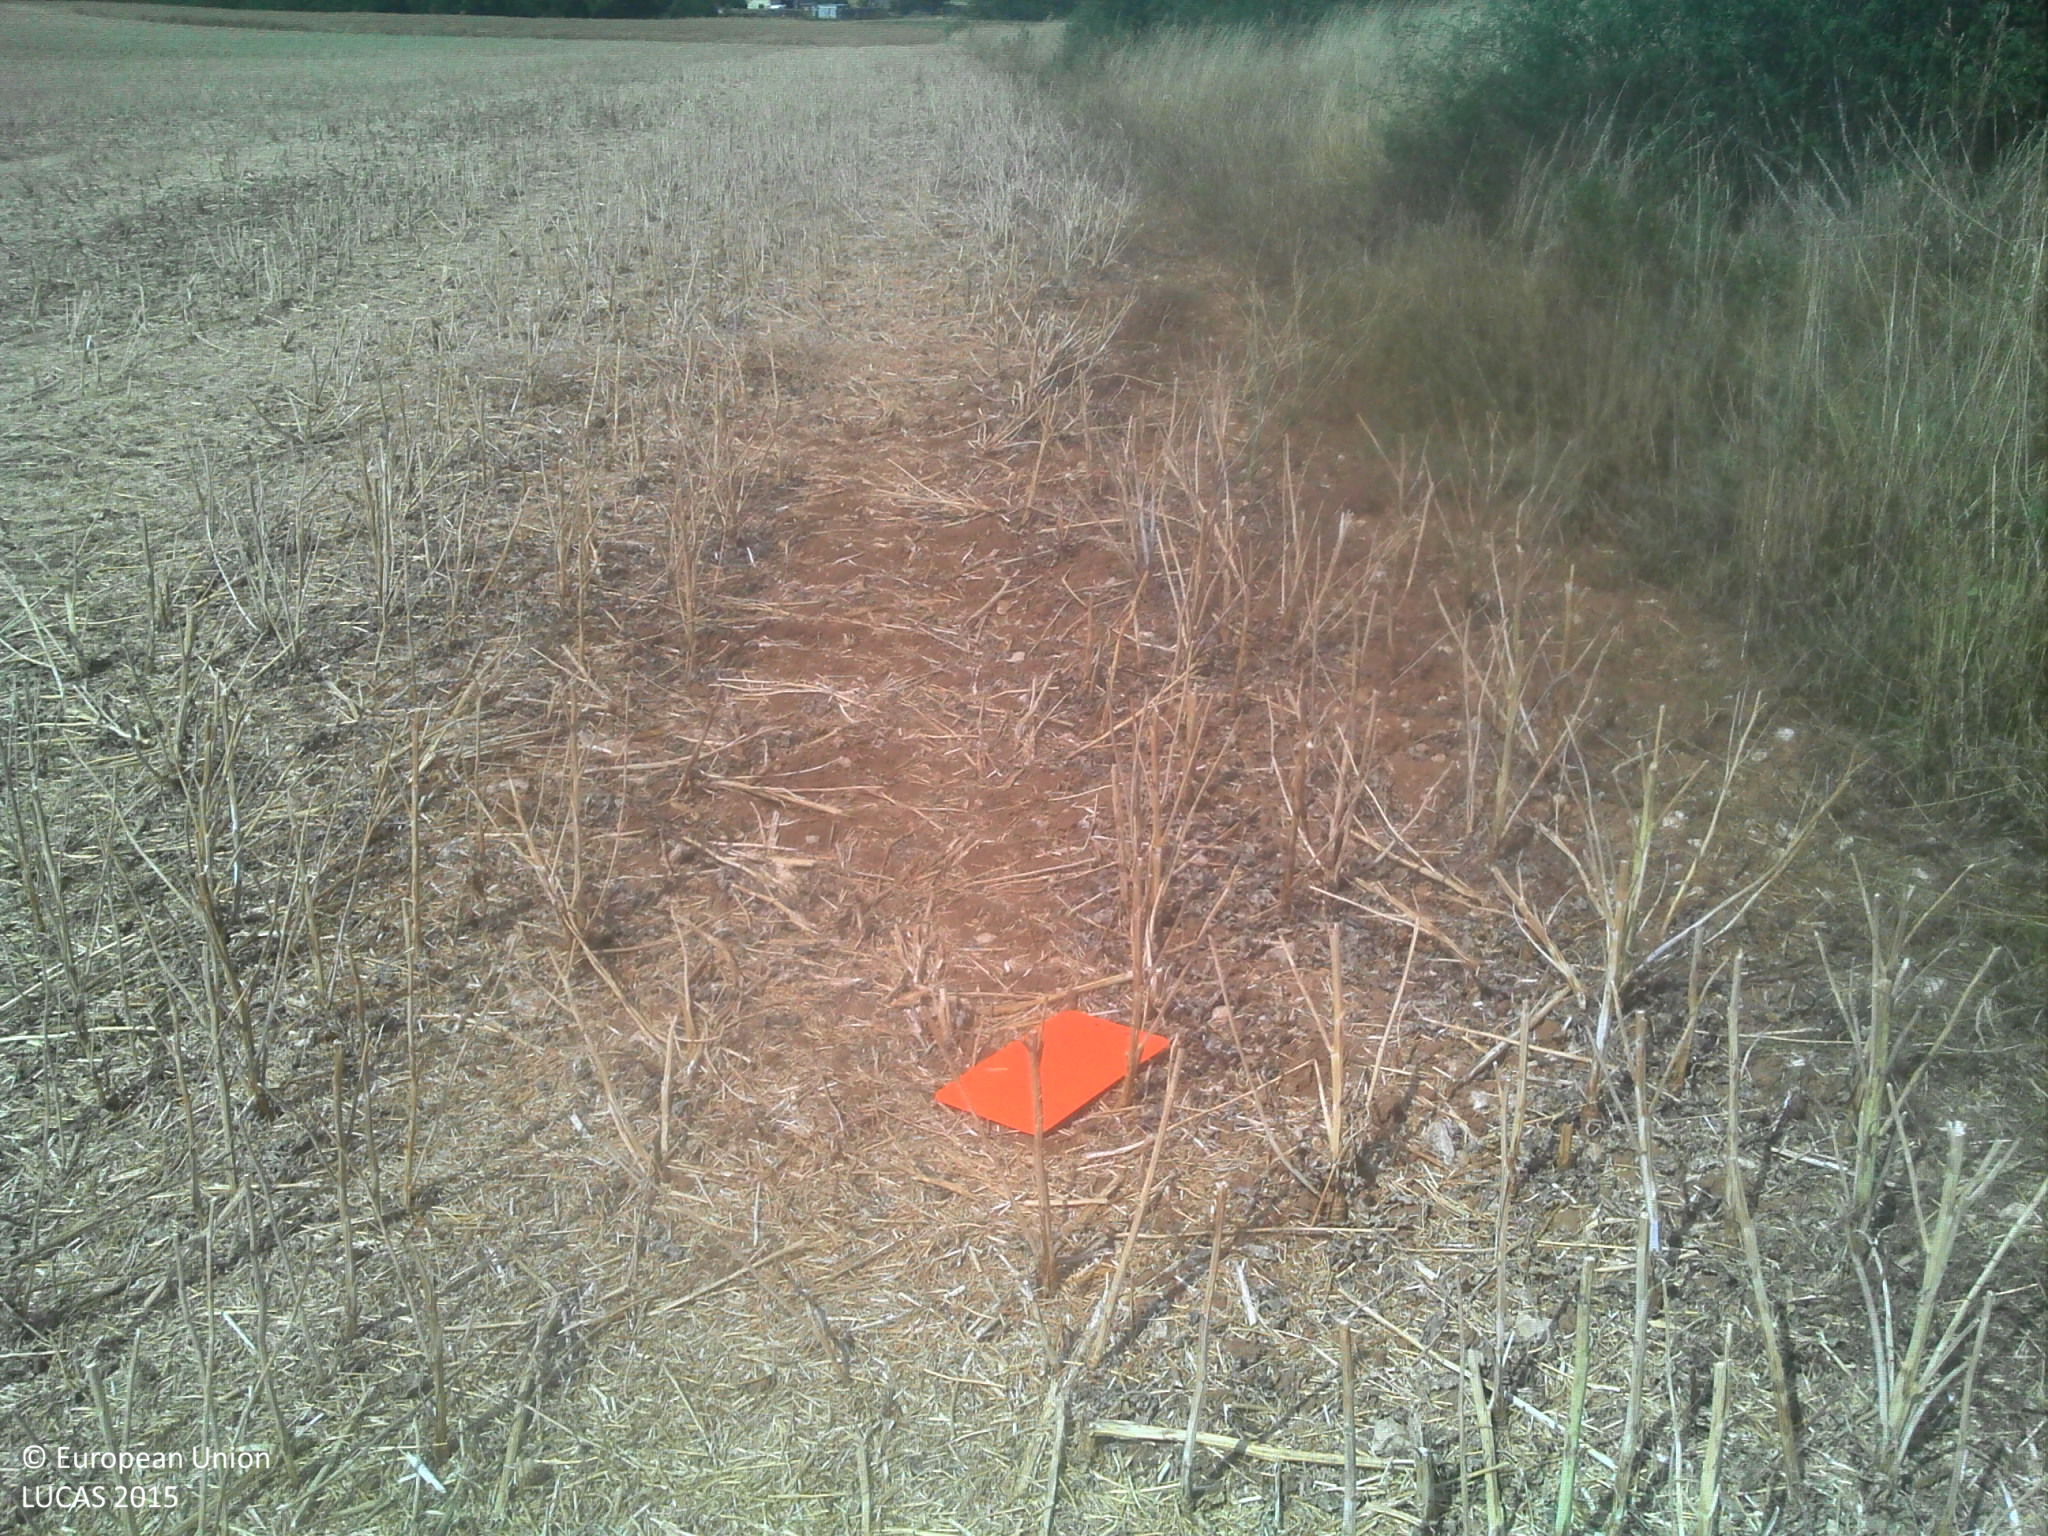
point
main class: Cropland
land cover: Rape and turnip rape
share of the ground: > 75 %
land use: Agriculture (excluding fallow land and kitchen gardens)
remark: Harvested field
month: July
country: FR
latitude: 47.9530
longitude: 1.3197
